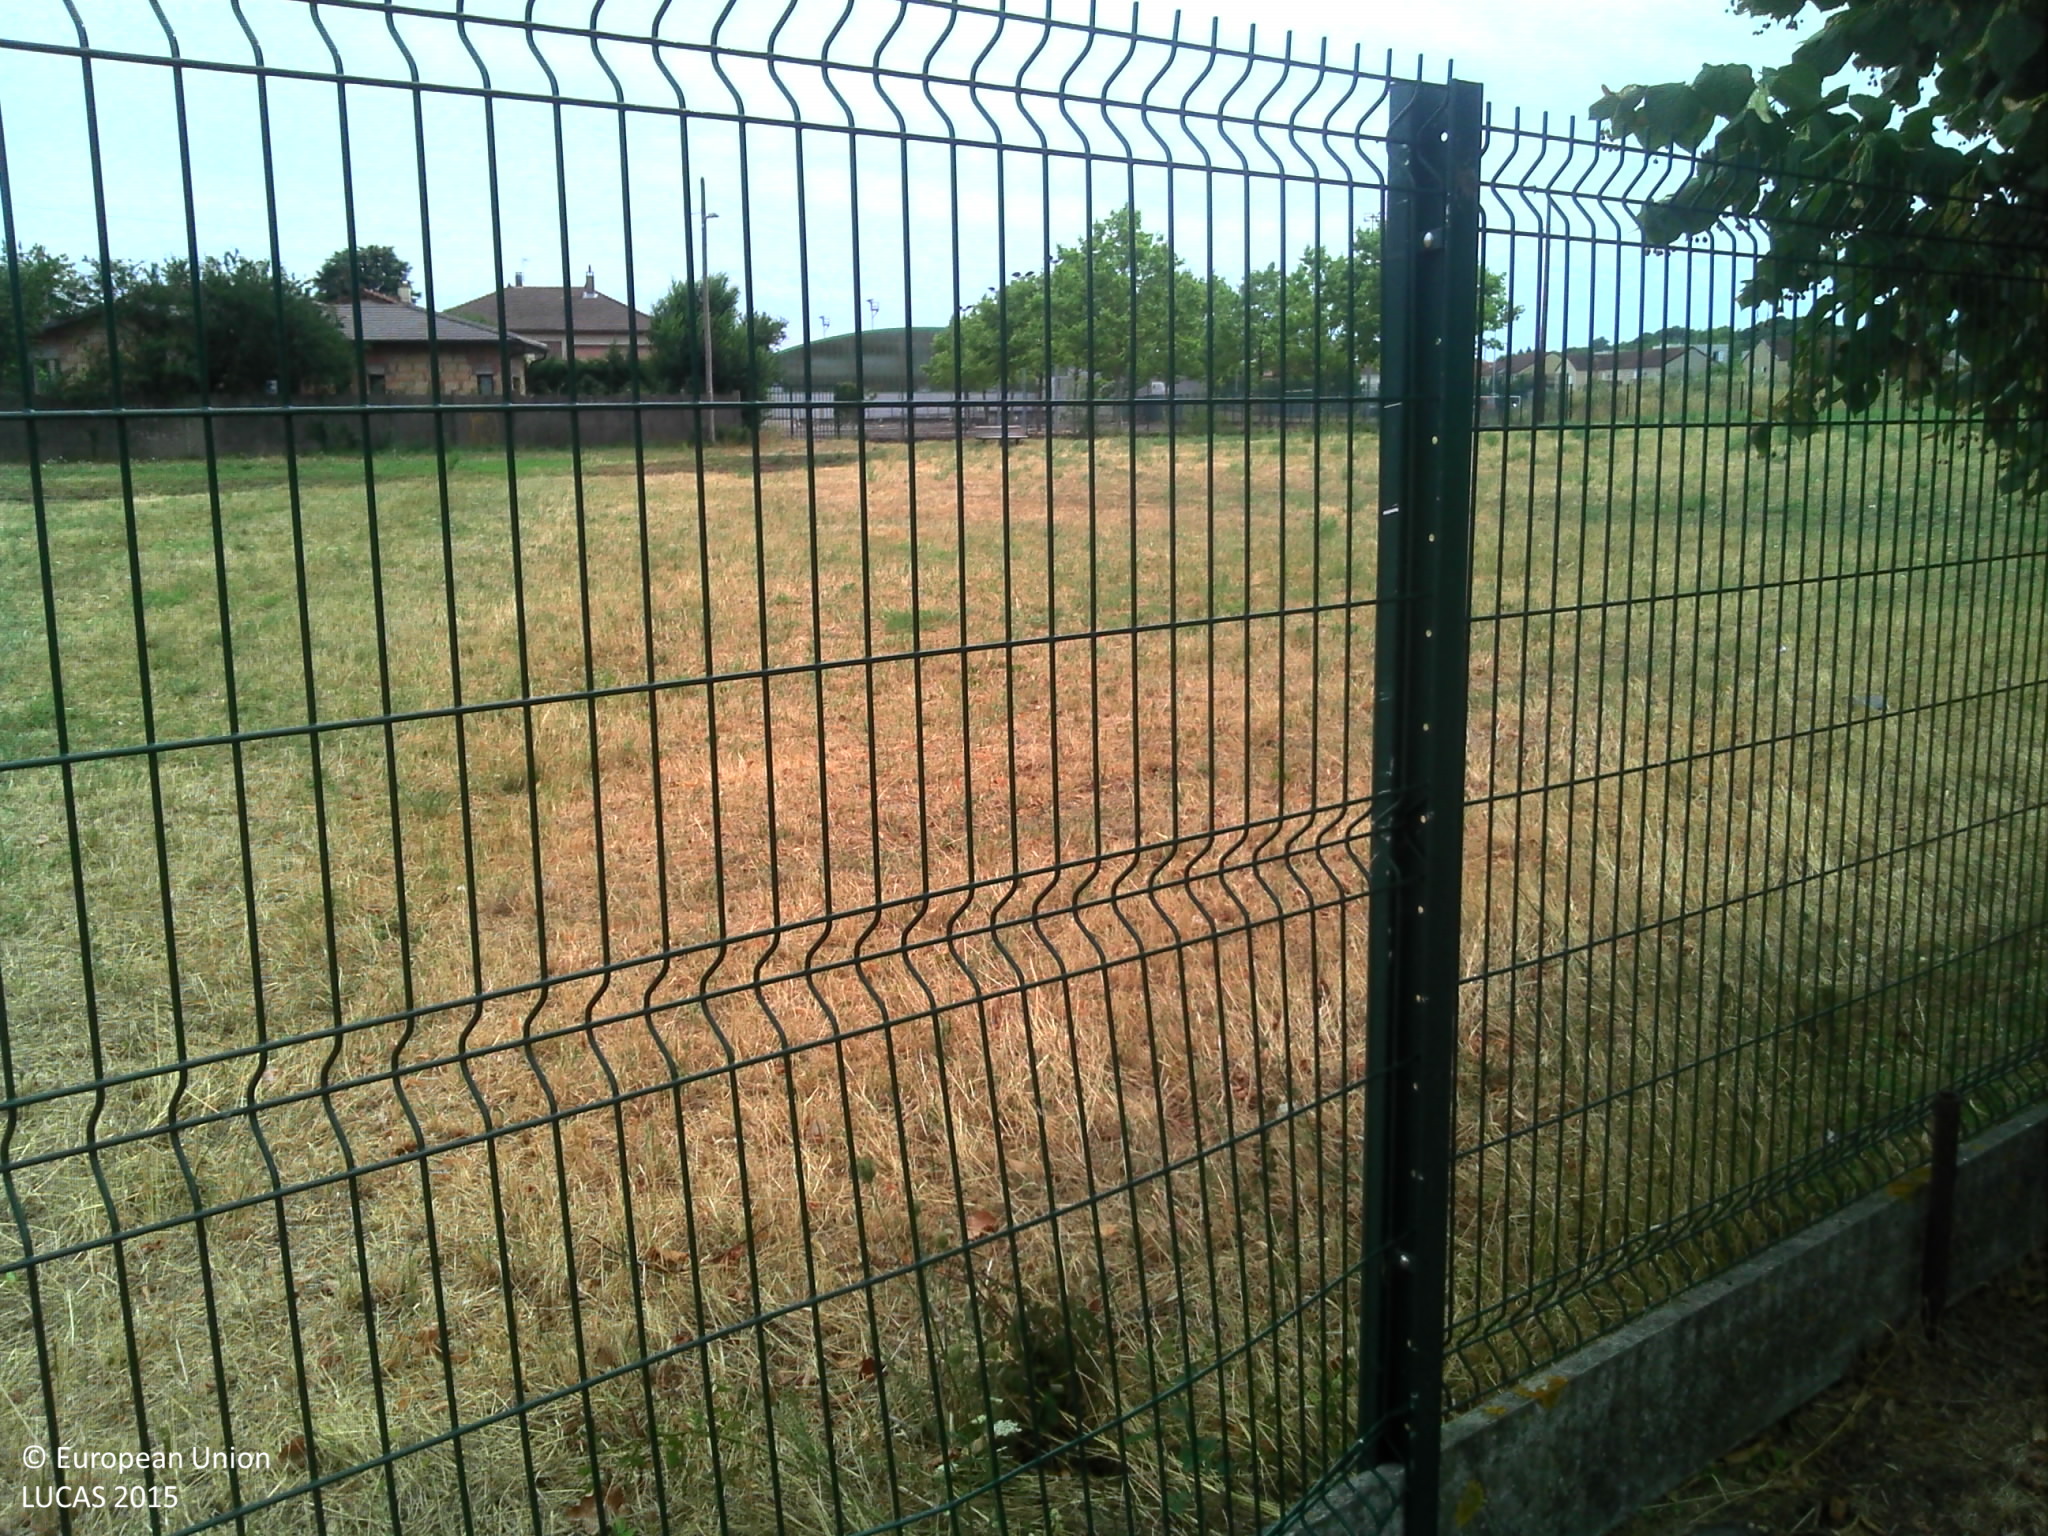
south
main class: Grassland
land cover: Grassland without tree/shrub cover
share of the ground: > 75 %
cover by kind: herbaceous plants 100 %
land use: Amenities, museums, leisure
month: July
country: FR
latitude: 45.7435
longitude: 4.9267
